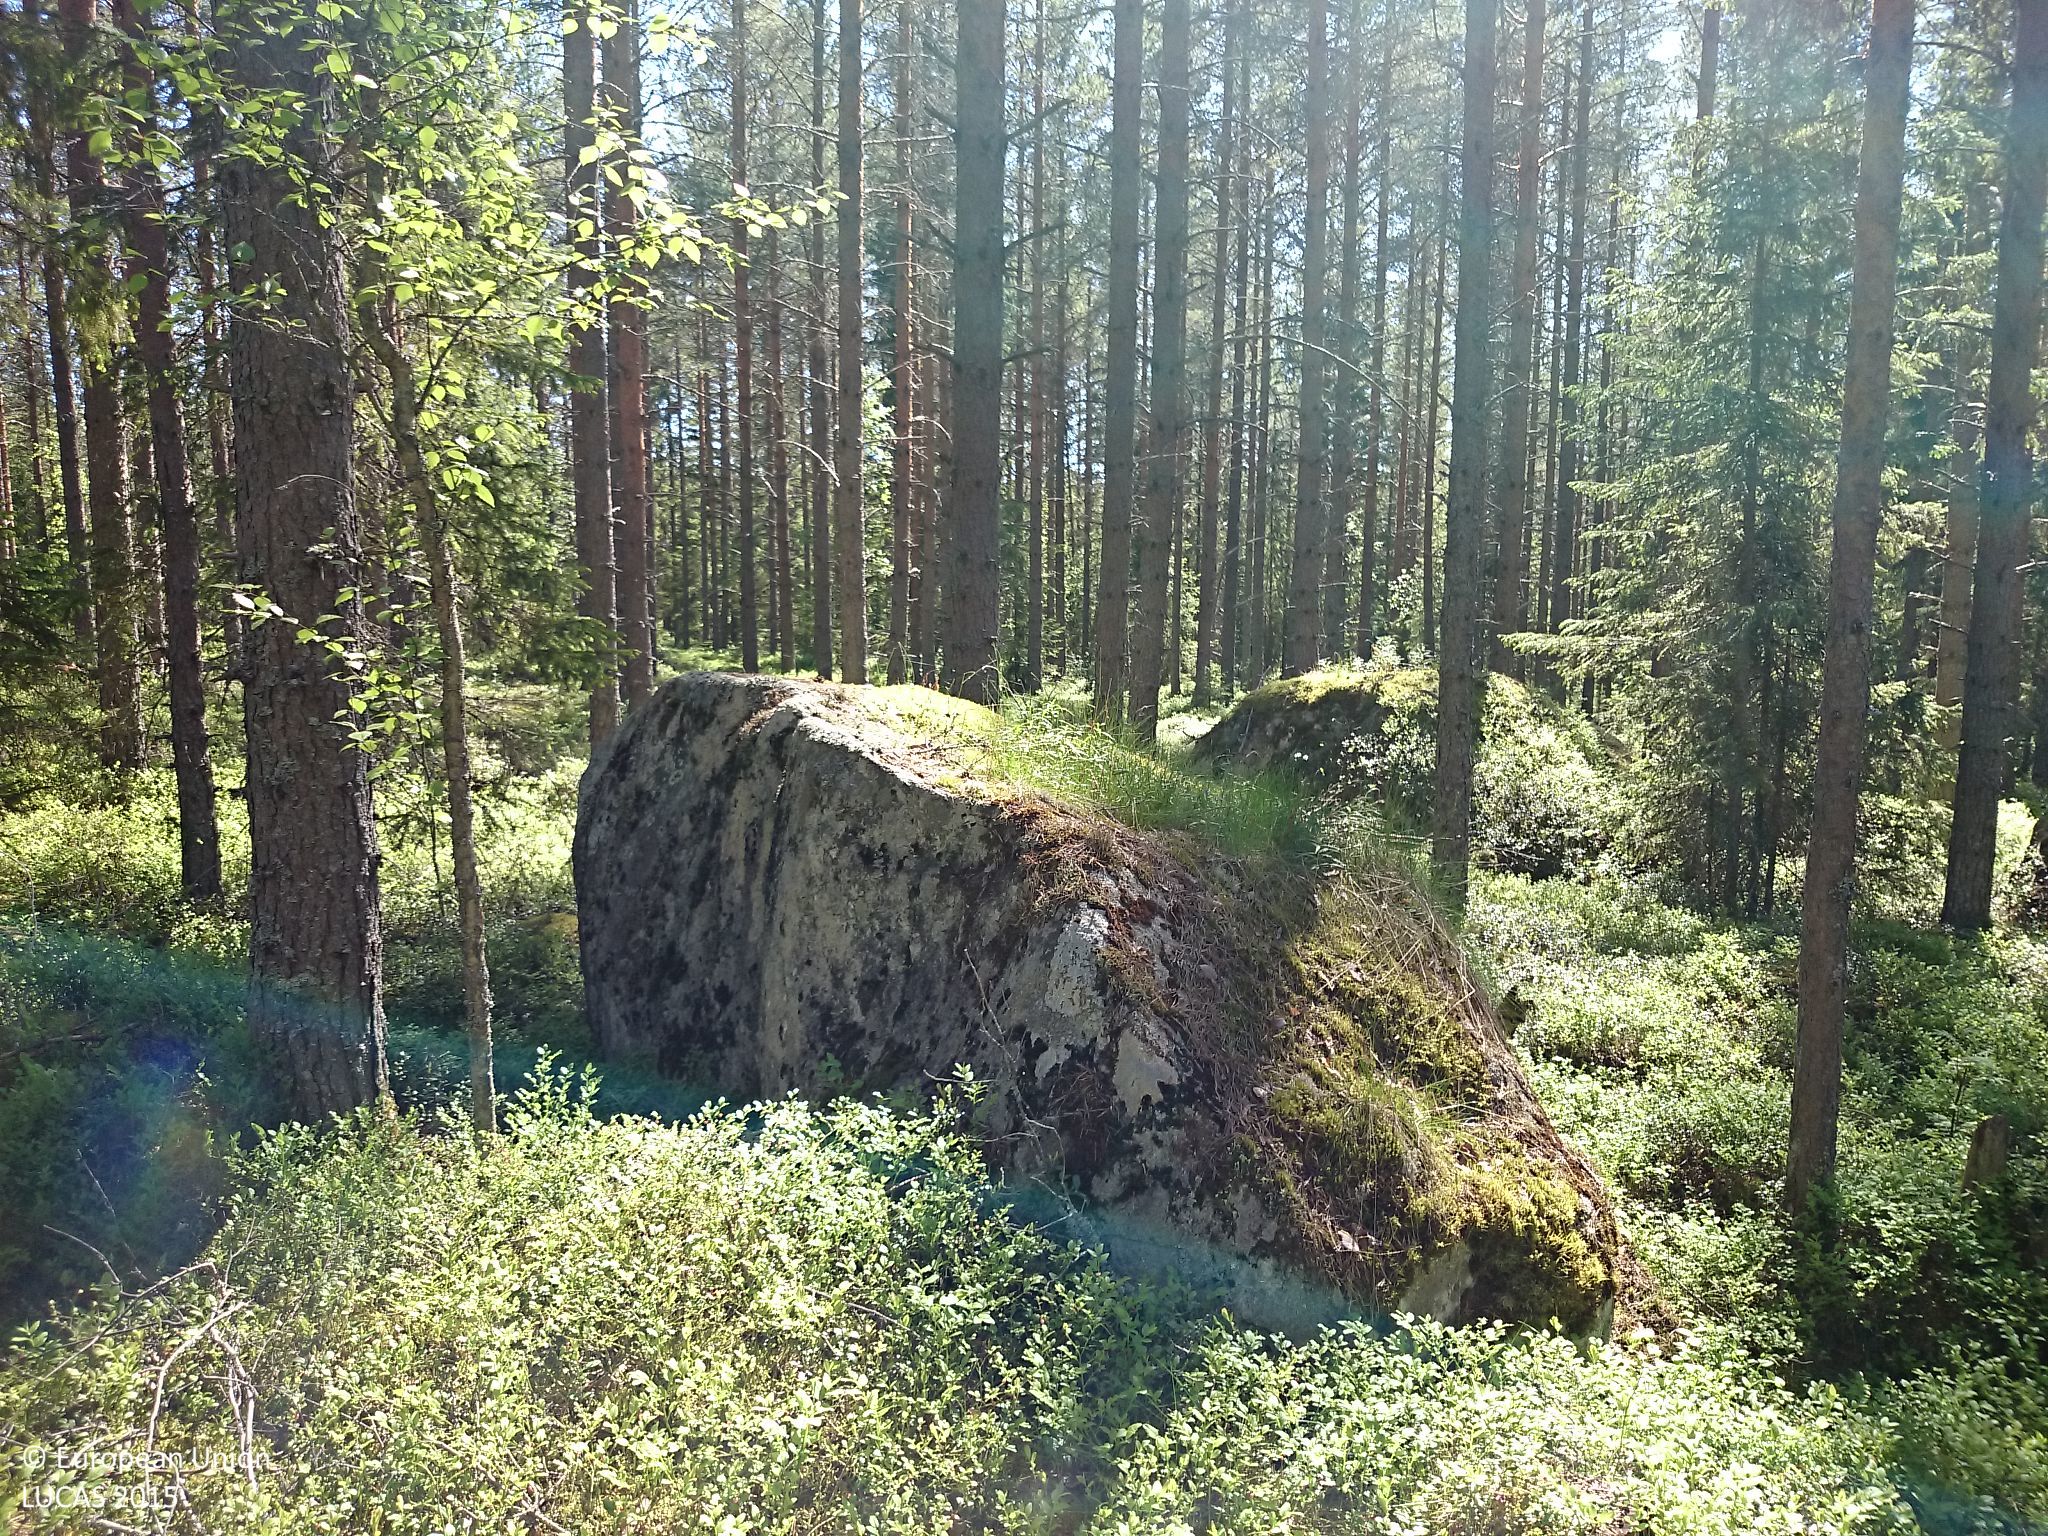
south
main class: Woodland
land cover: Pine dominated coniferous woodland
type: boreal forest
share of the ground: 50 - 75 %
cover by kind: coniferous forest trees 65 %, shrubs 35 %
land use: Forestry
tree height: > 5 m
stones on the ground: > 50 %
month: June
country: SE
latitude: 63.9597
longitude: 20.7436
